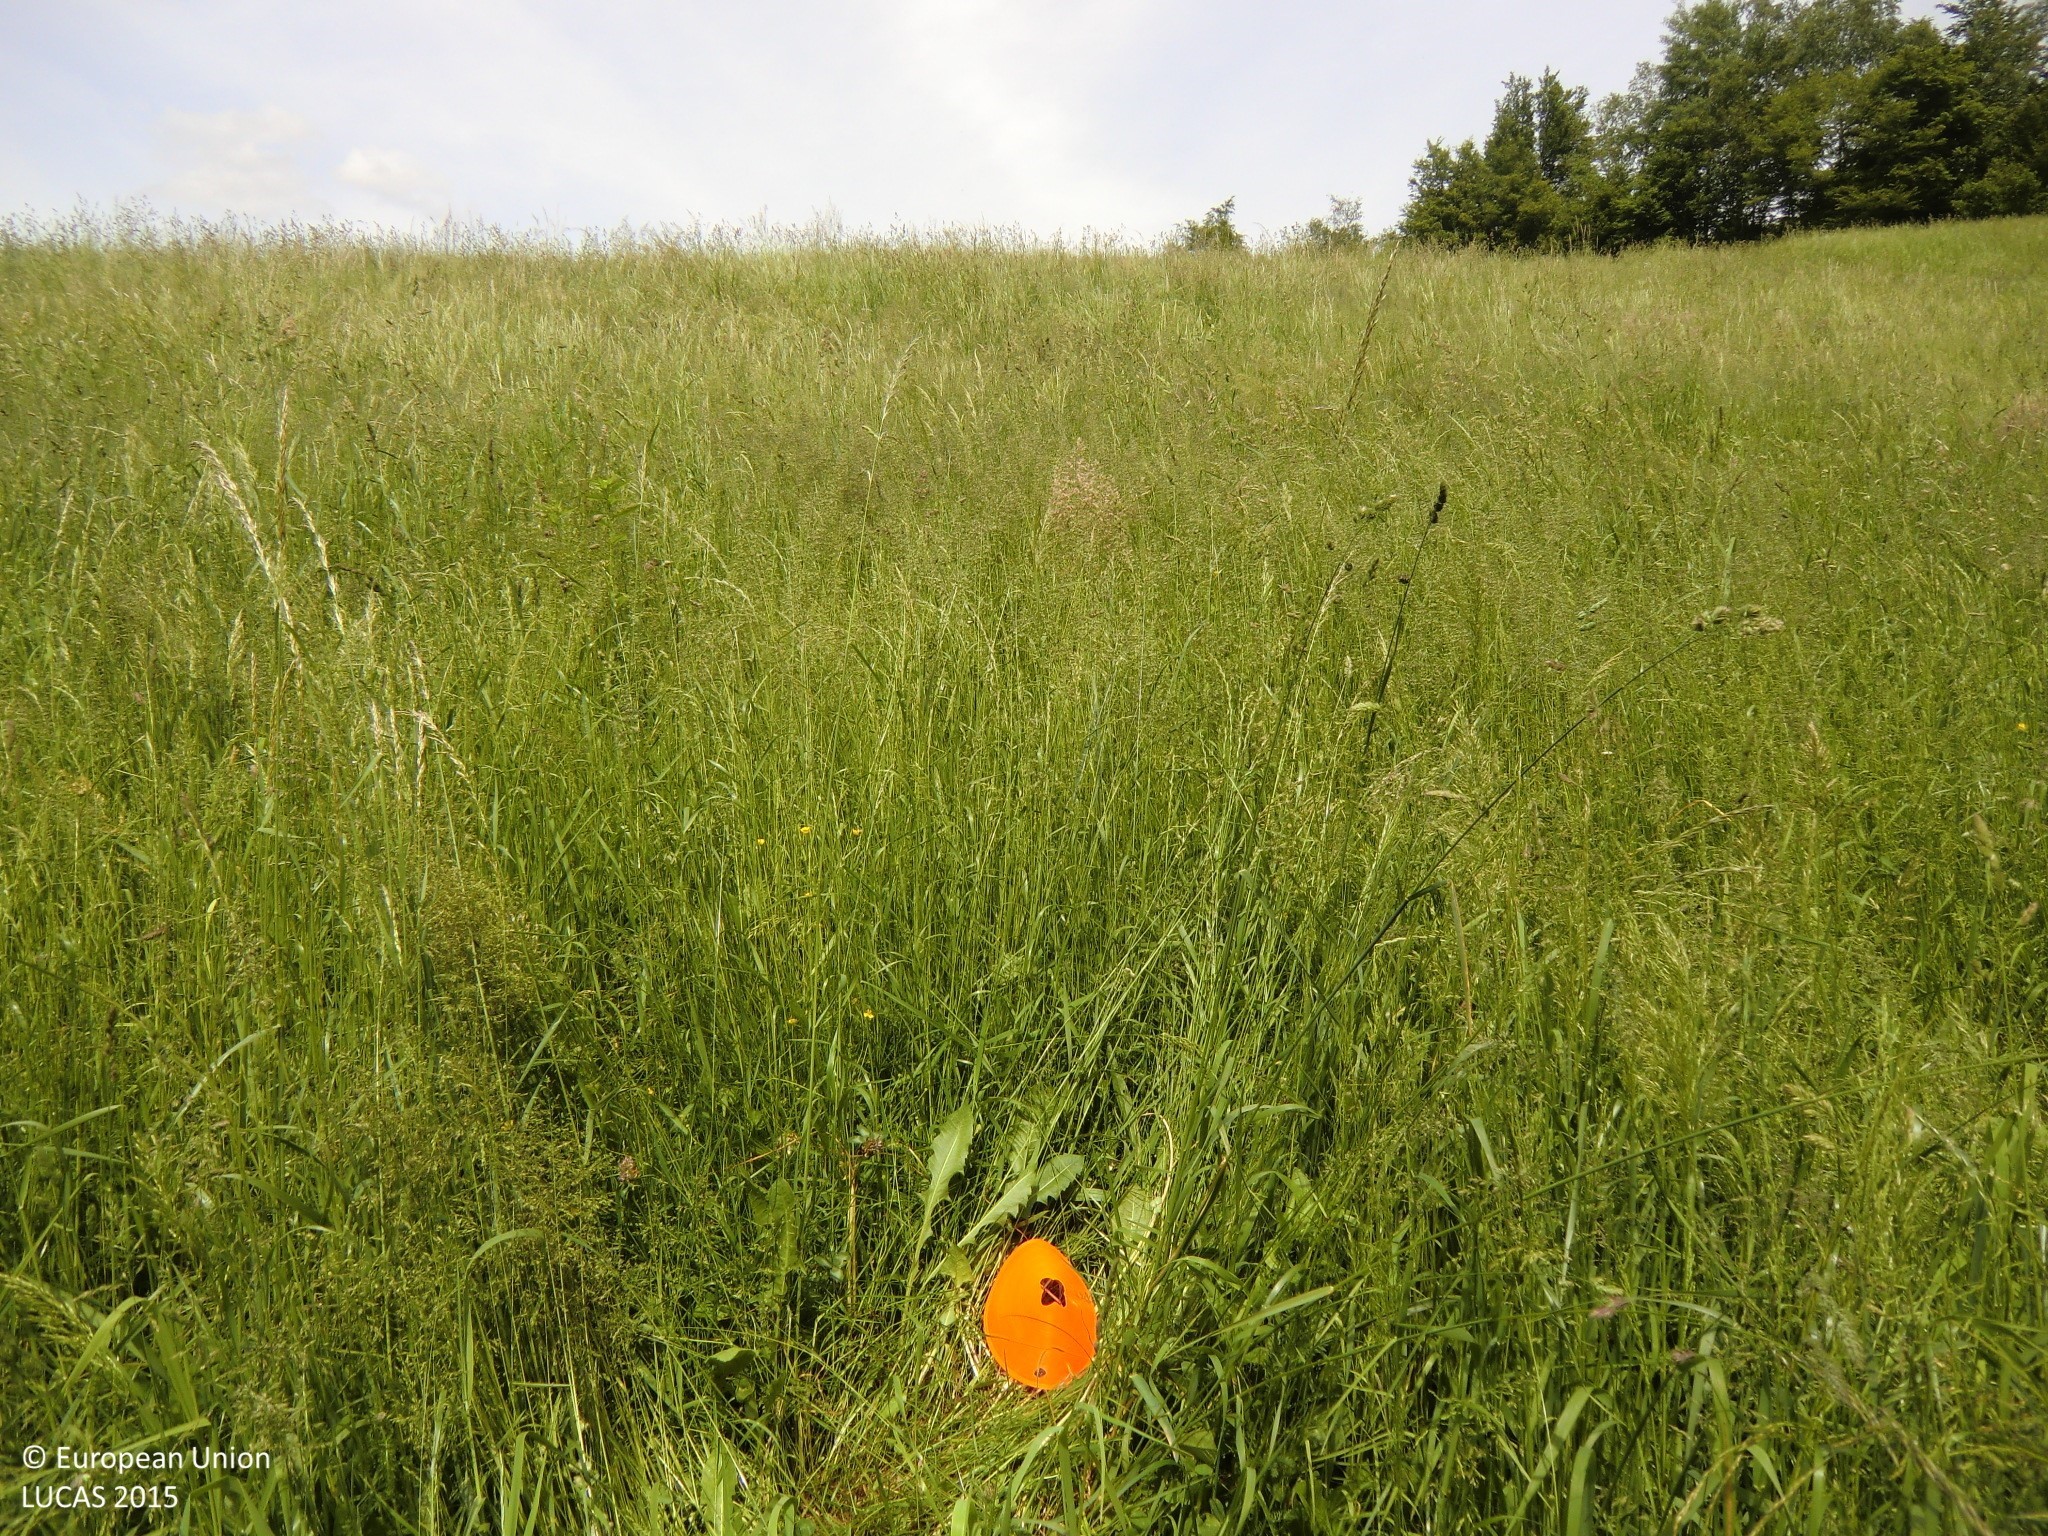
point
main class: Grassland
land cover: Grassland without tree/shrub cover
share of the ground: > 75 %
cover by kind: herbaceous plants 100 %
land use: Agriculture (excluding fallow land and kitchen gardens)
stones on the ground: < 10 %
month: May
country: AT
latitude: 48.2006
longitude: 14.9929
